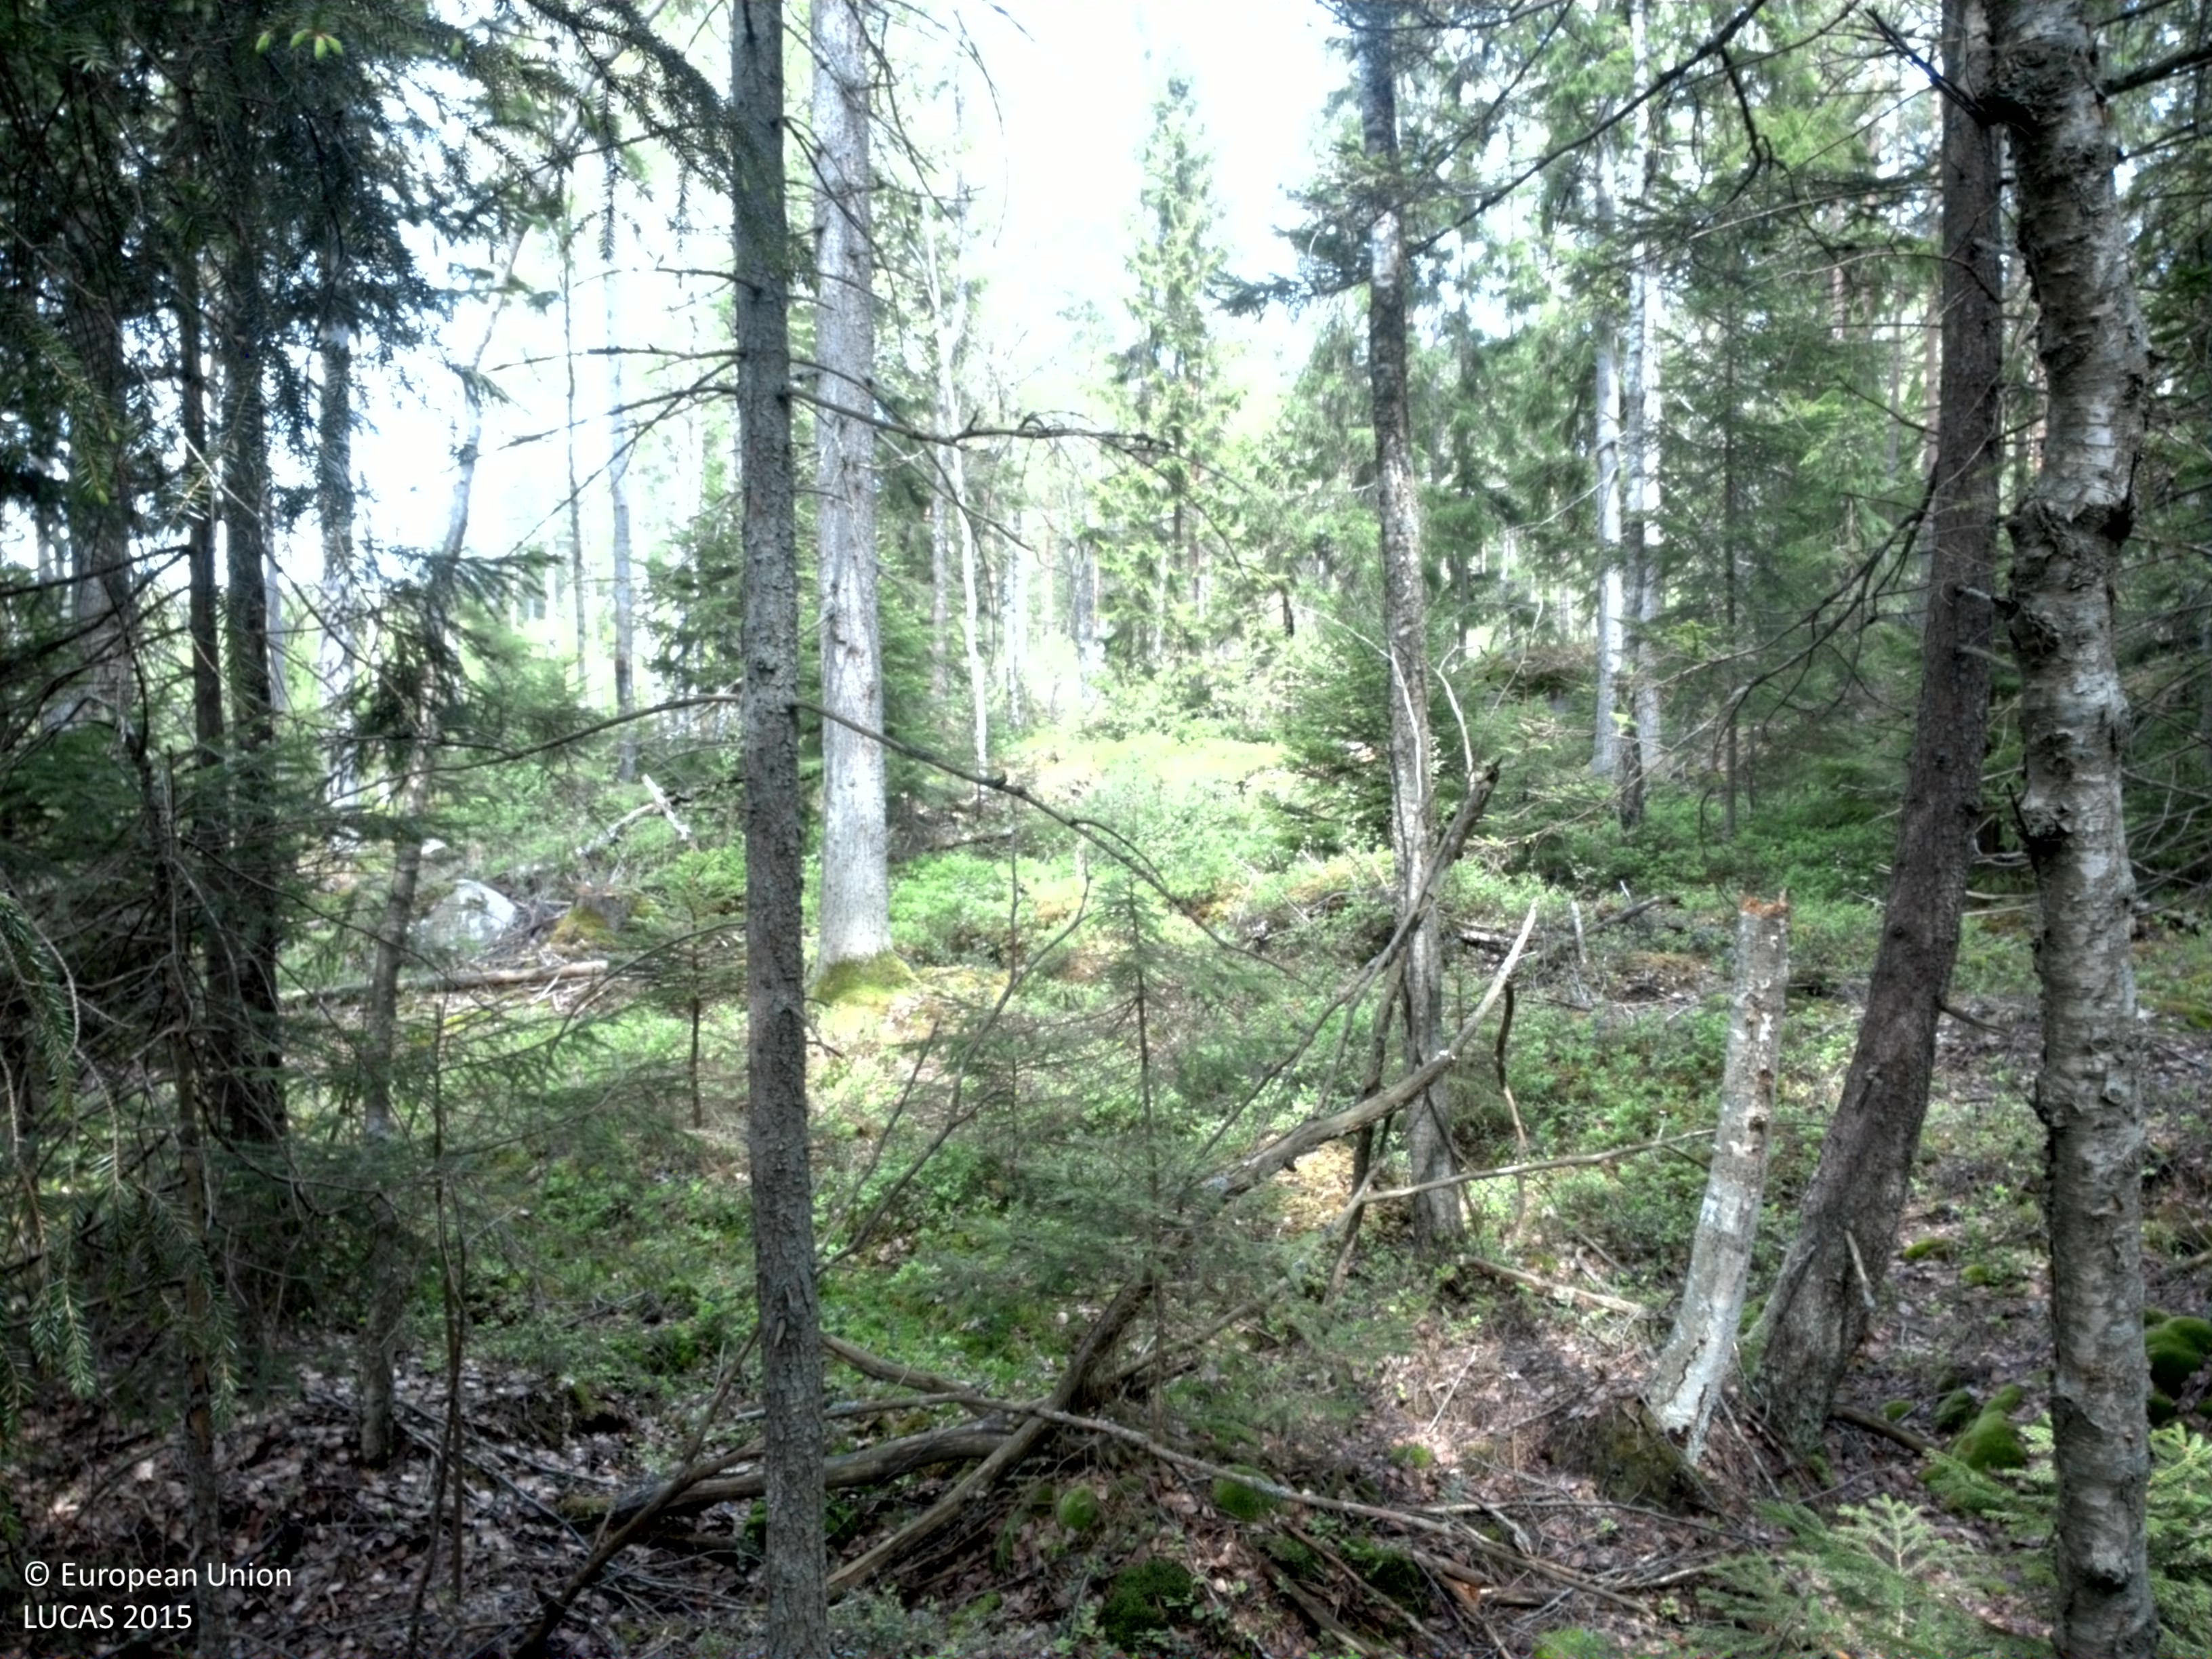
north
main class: Woodland
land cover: Spruce dominated mixed woodland
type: boreal forest
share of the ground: > 75 %
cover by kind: broadleaved forest trees 50 %, coniferous forest trees 40 %, lichens and mosses 10 %
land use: Forestry
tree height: > 5 m
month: May
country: SE
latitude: 56.7908
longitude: 15.0562
